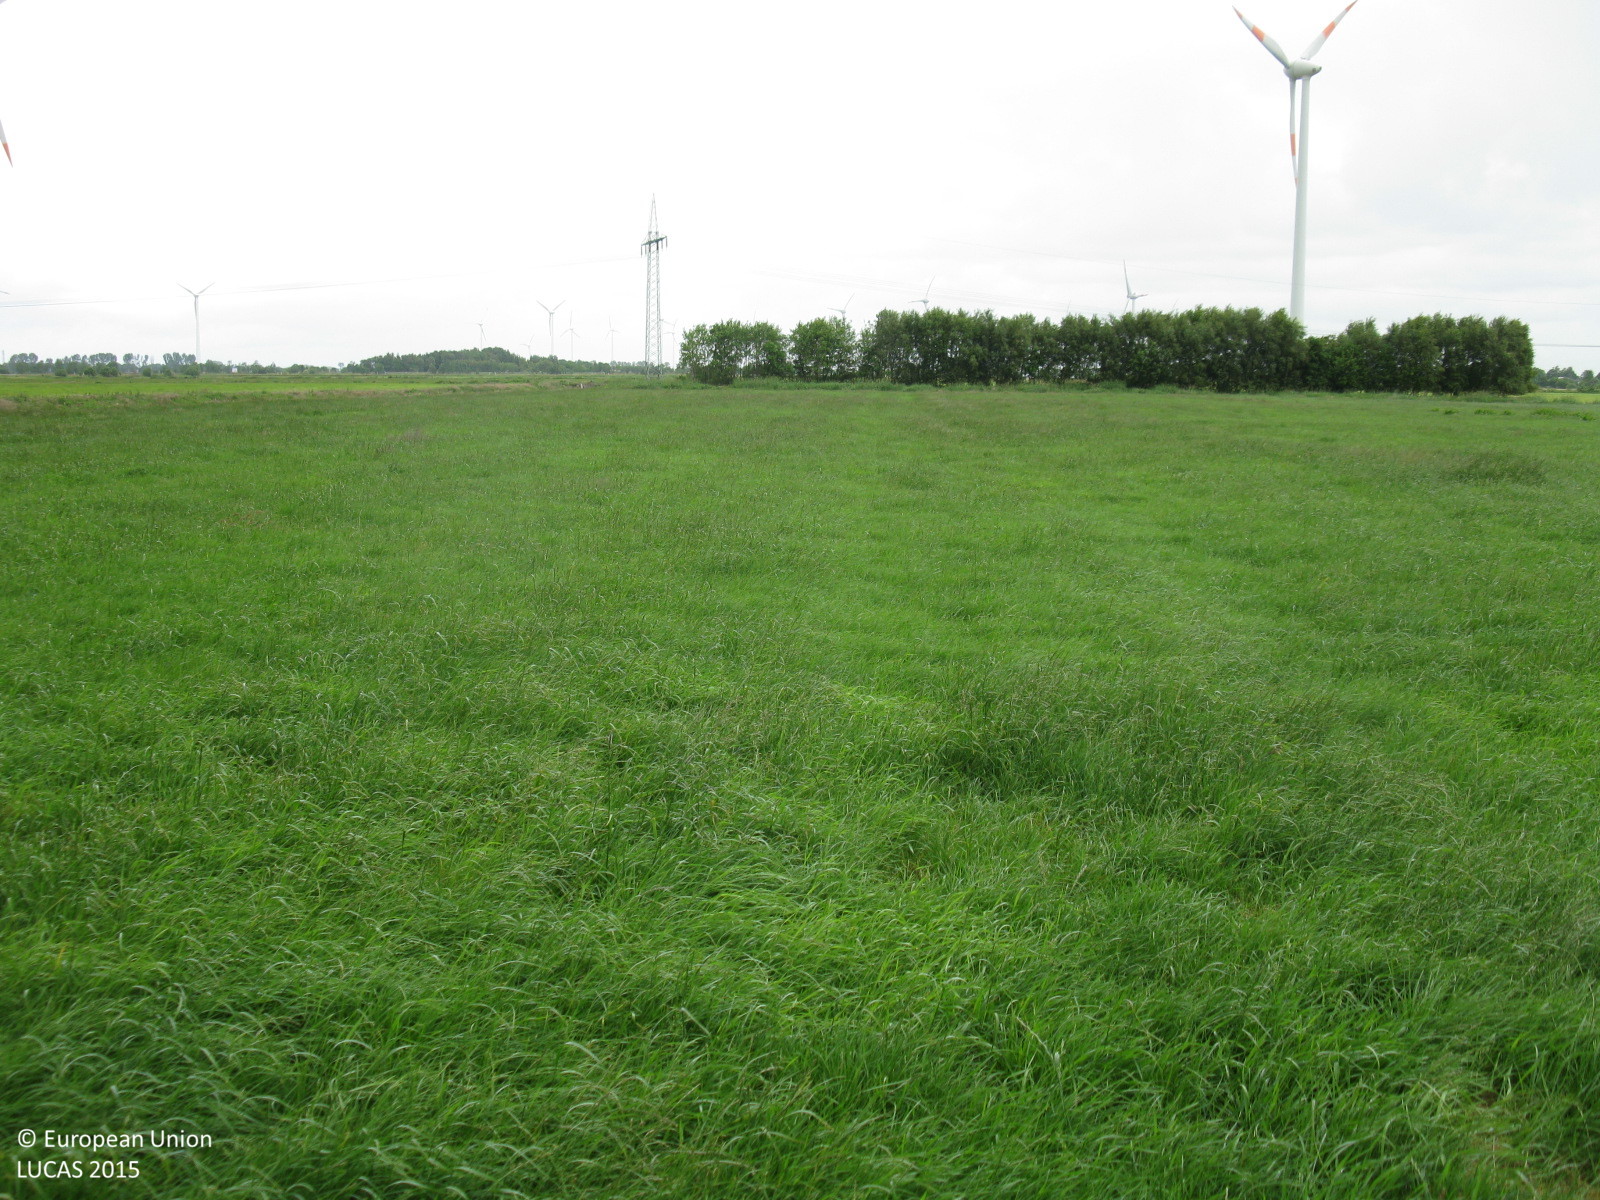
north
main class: Grassland
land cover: Grassland without tree/shrub cover
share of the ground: > 75 %
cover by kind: herbaceous plants 100 %
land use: Agriculture (excluding fallow land and kitchen gardens)
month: June
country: DE
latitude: 53.3554
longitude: 7.3713
